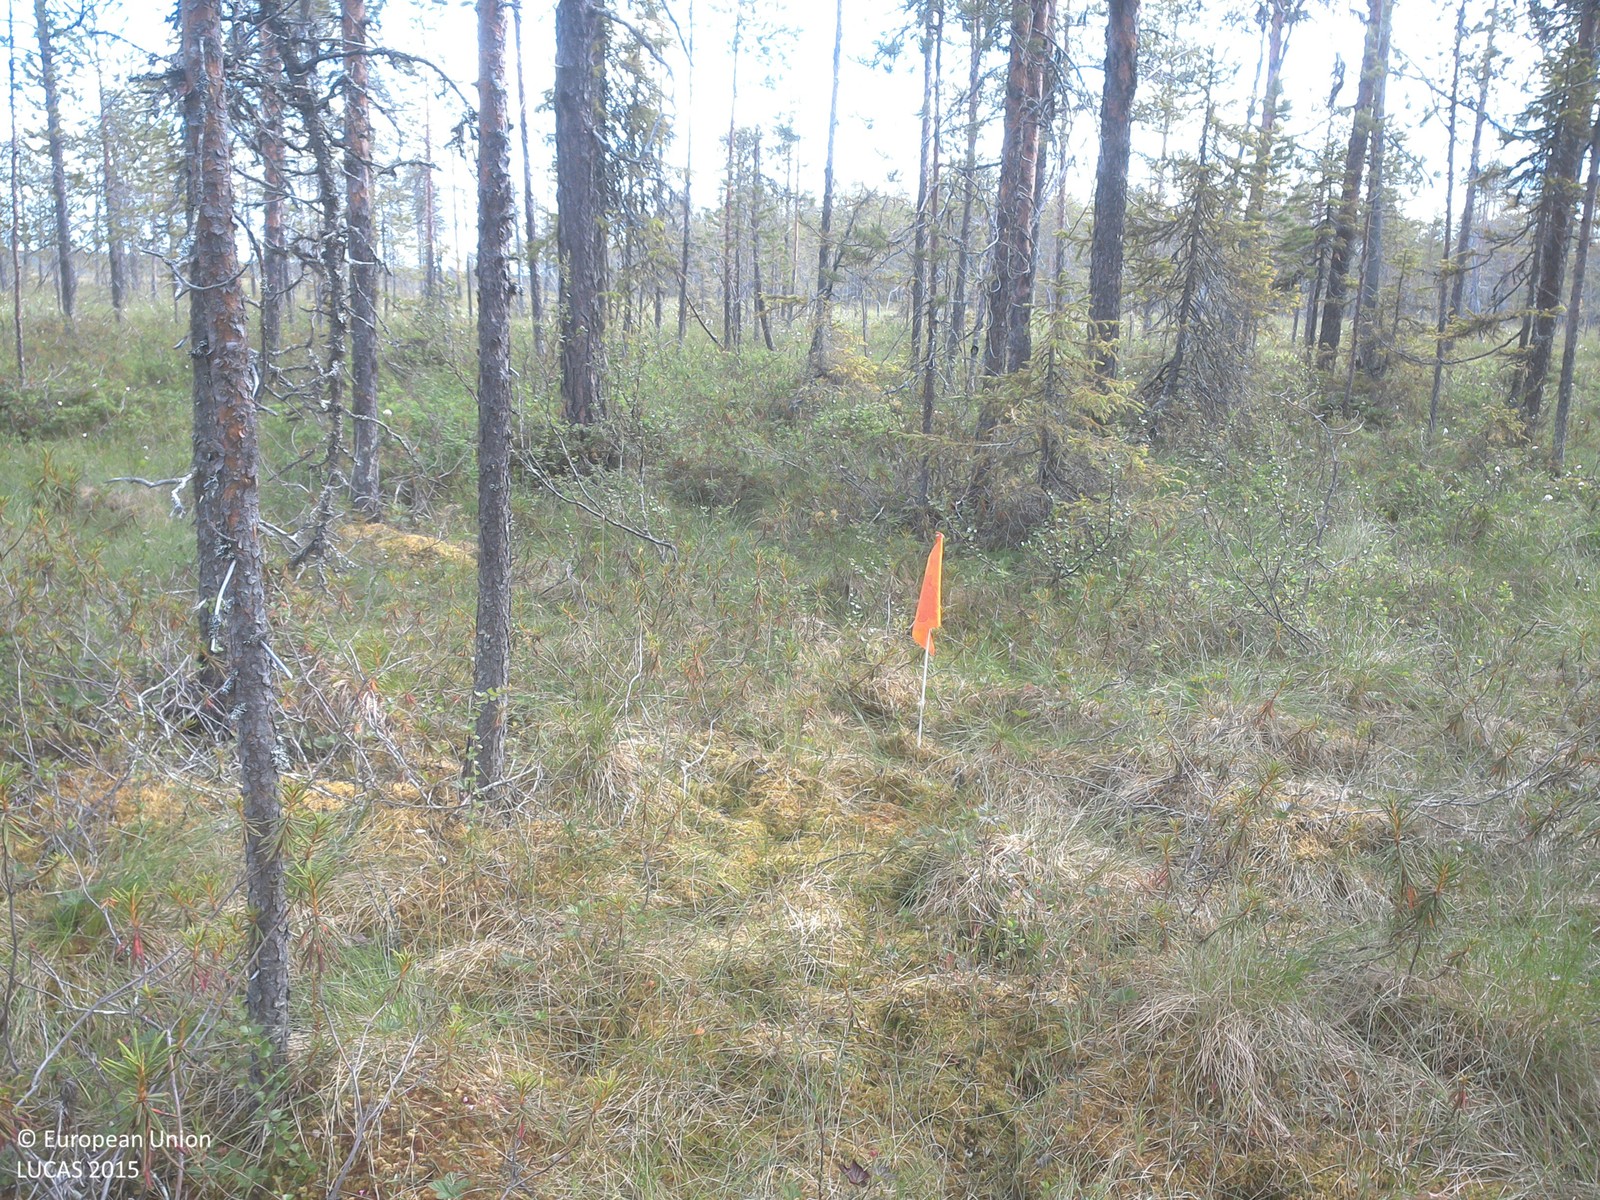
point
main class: Woodland
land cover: Pine dominated coniferous woodland
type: boreal forest
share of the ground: 10 - 25 %
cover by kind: shrubs 35 %, herbaceous plants 30 %, coniferous forest trees 20 %, lichens and mosses 15 %
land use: Semi-natural and natural areas not in use
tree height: > 5 m
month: July
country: SE
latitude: 67.4987
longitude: 23.2897
